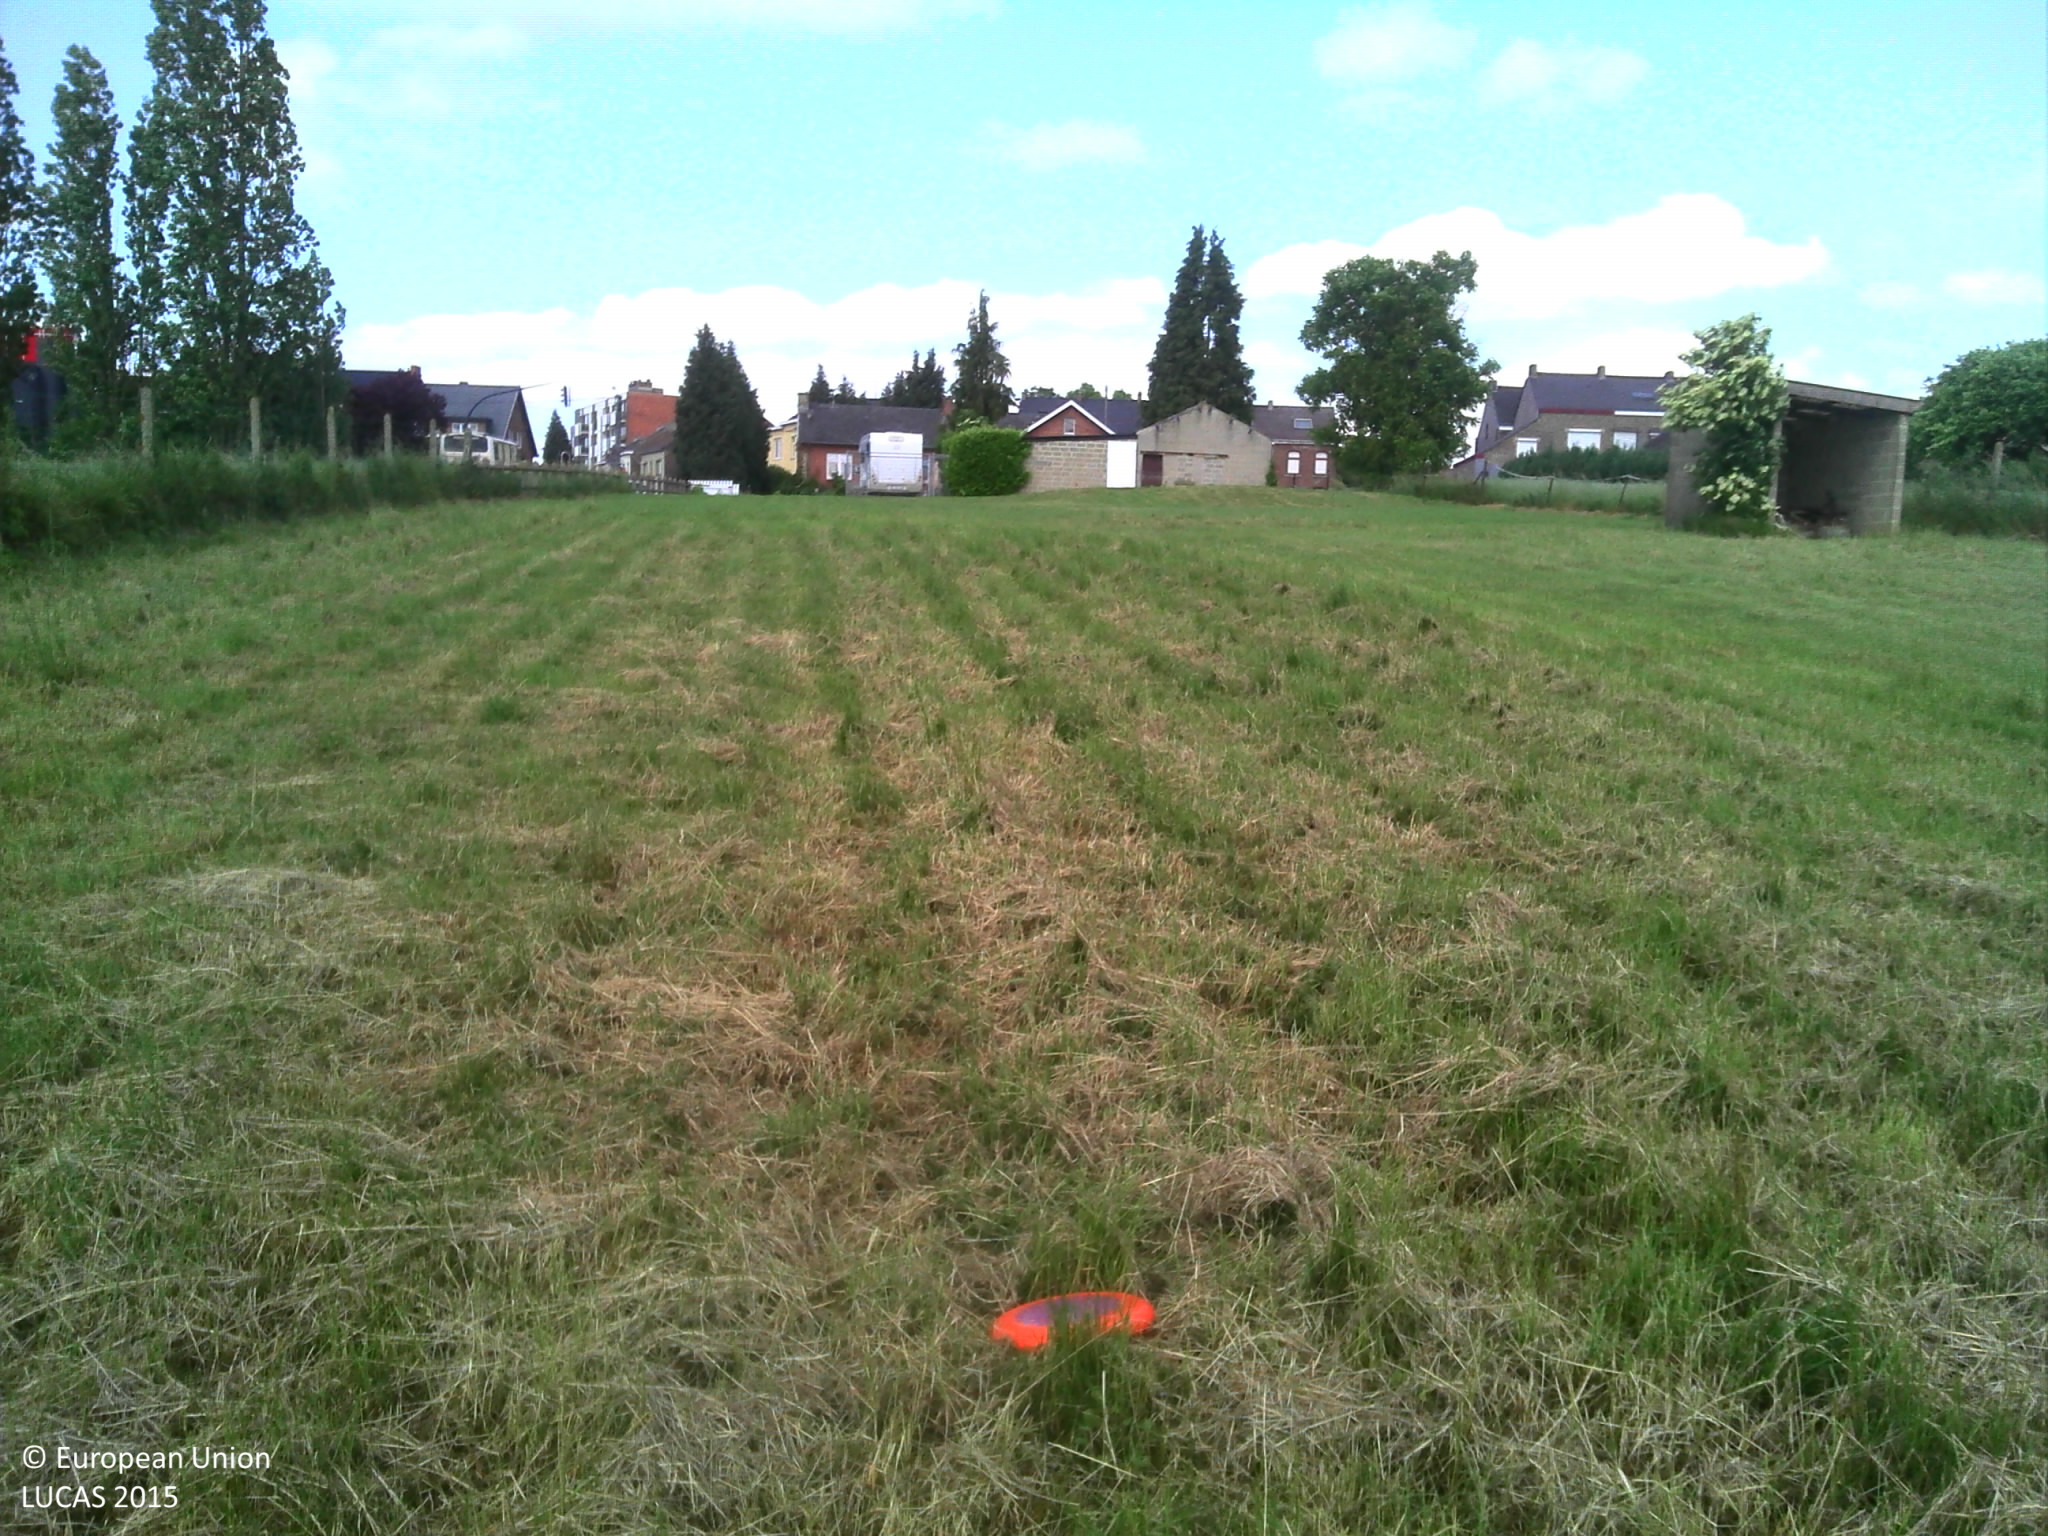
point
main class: Grassland
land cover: Grassland without tree/shrub cover
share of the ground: > 75 %
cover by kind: herbaceous plants 100 %
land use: Residential
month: June
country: BE
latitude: 50.4363
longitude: 4.6320
